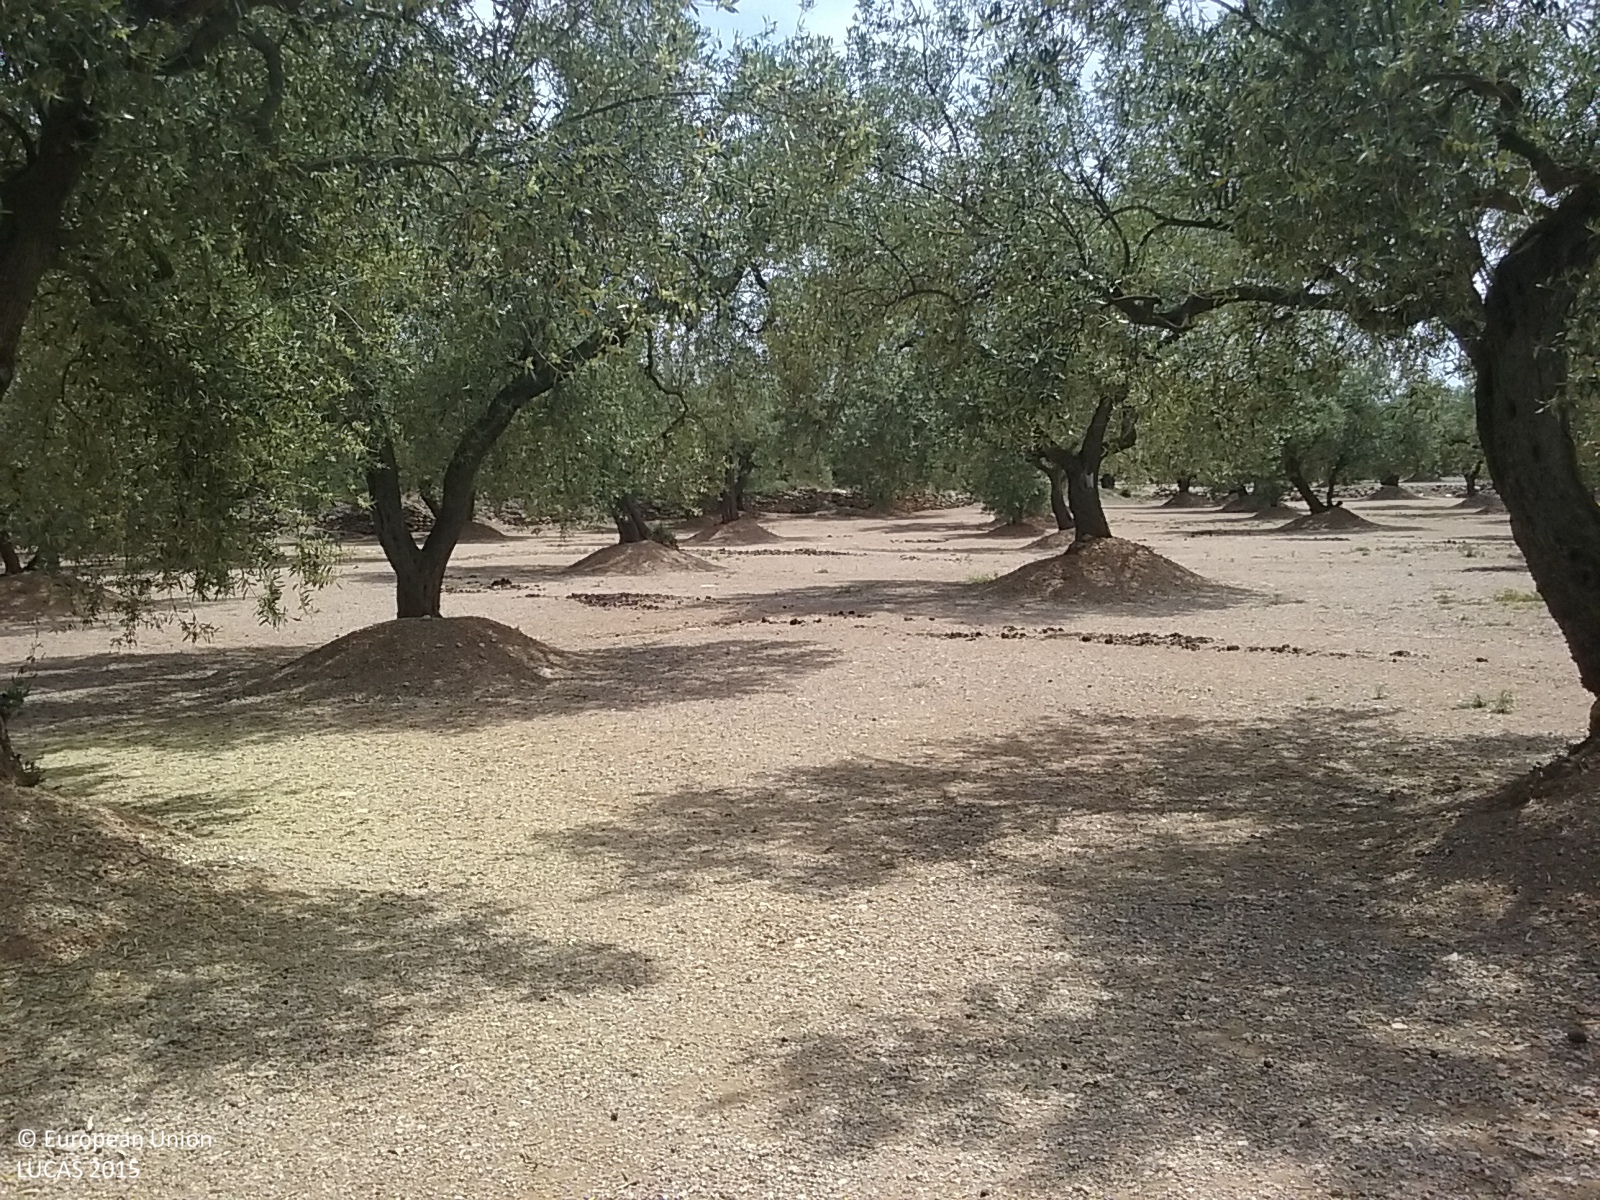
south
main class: Cropland
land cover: Olive groves
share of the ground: 50 - 75 %
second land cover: Other bare soil
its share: > 75 %
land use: Agriculture (excluding fallow land and kitchen gardens)
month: May
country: ES
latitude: 40.6671
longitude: 0.3774
